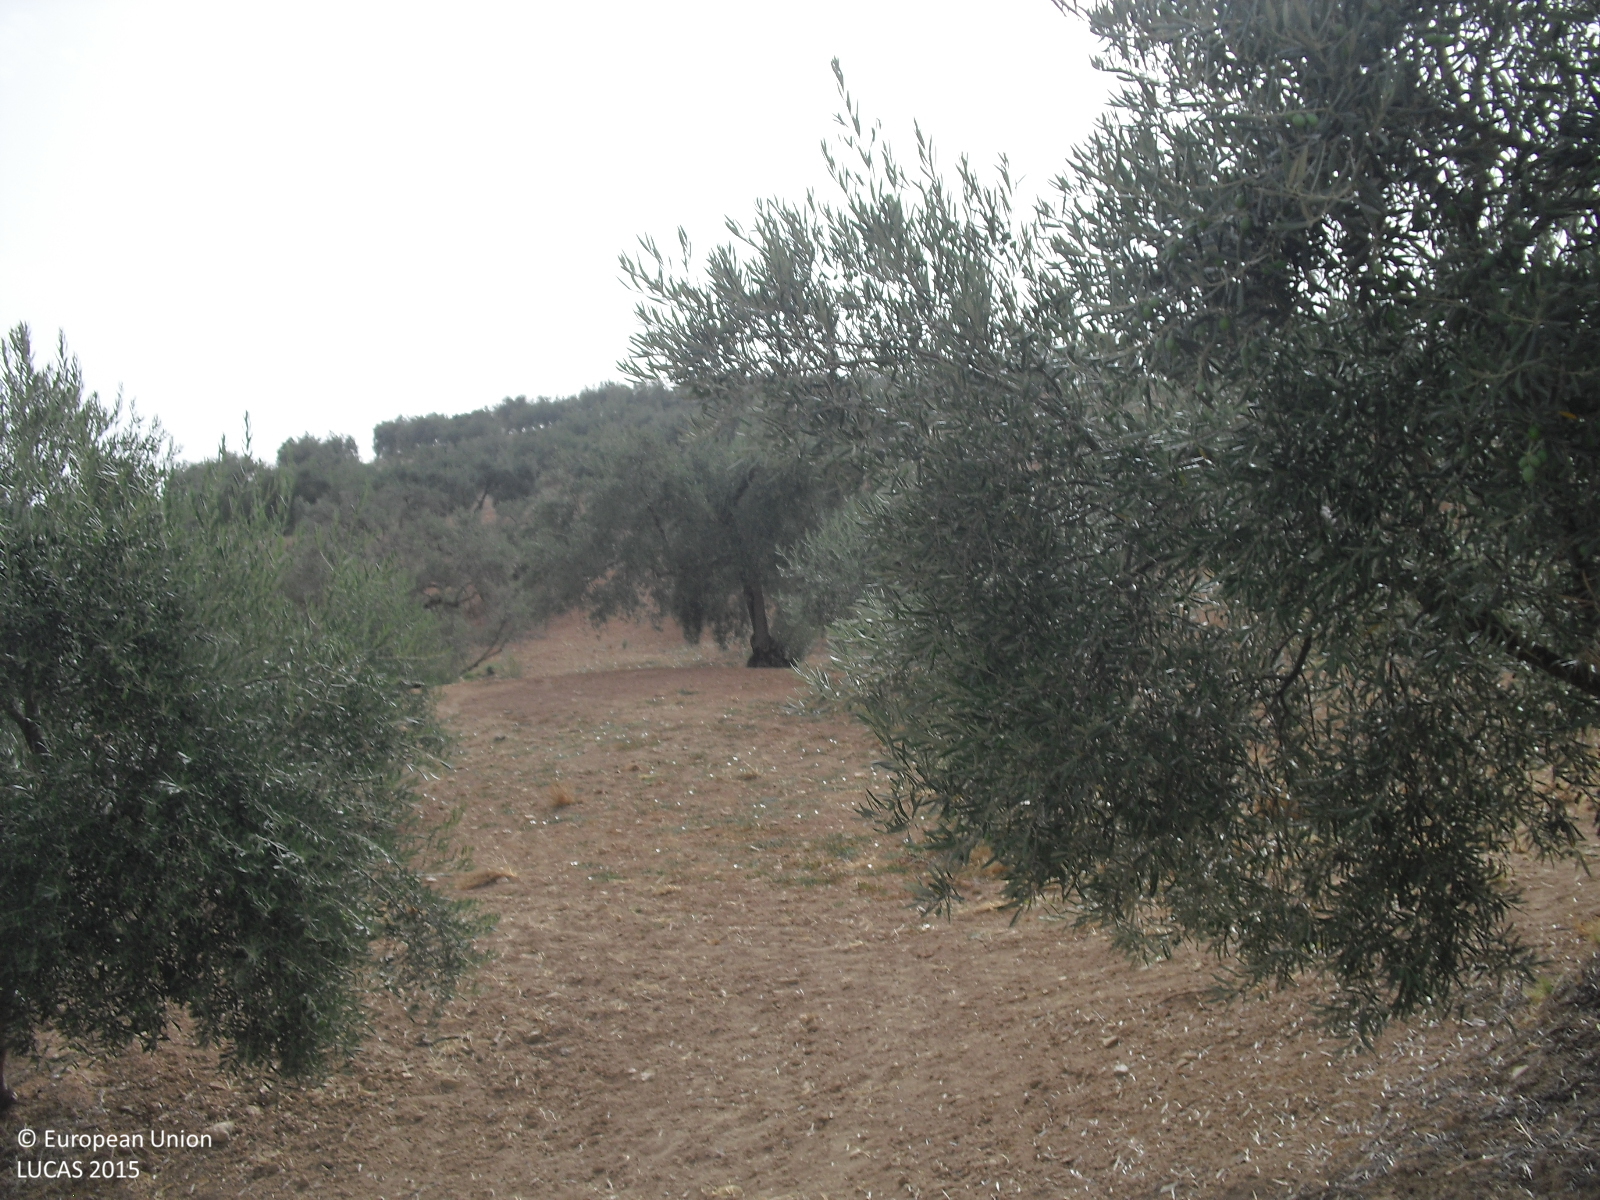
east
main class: Cropland
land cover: Olive groves
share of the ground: 10 - 25 %
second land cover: Spontaneously vegetated surfaces
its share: 10 - 25 %
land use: Agriculture (excluding fallow land and kitchen gardens)
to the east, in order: Olive groves; Spontaneously vegetated surfaces
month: August
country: ES
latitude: 37.2117
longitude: -4.1826
